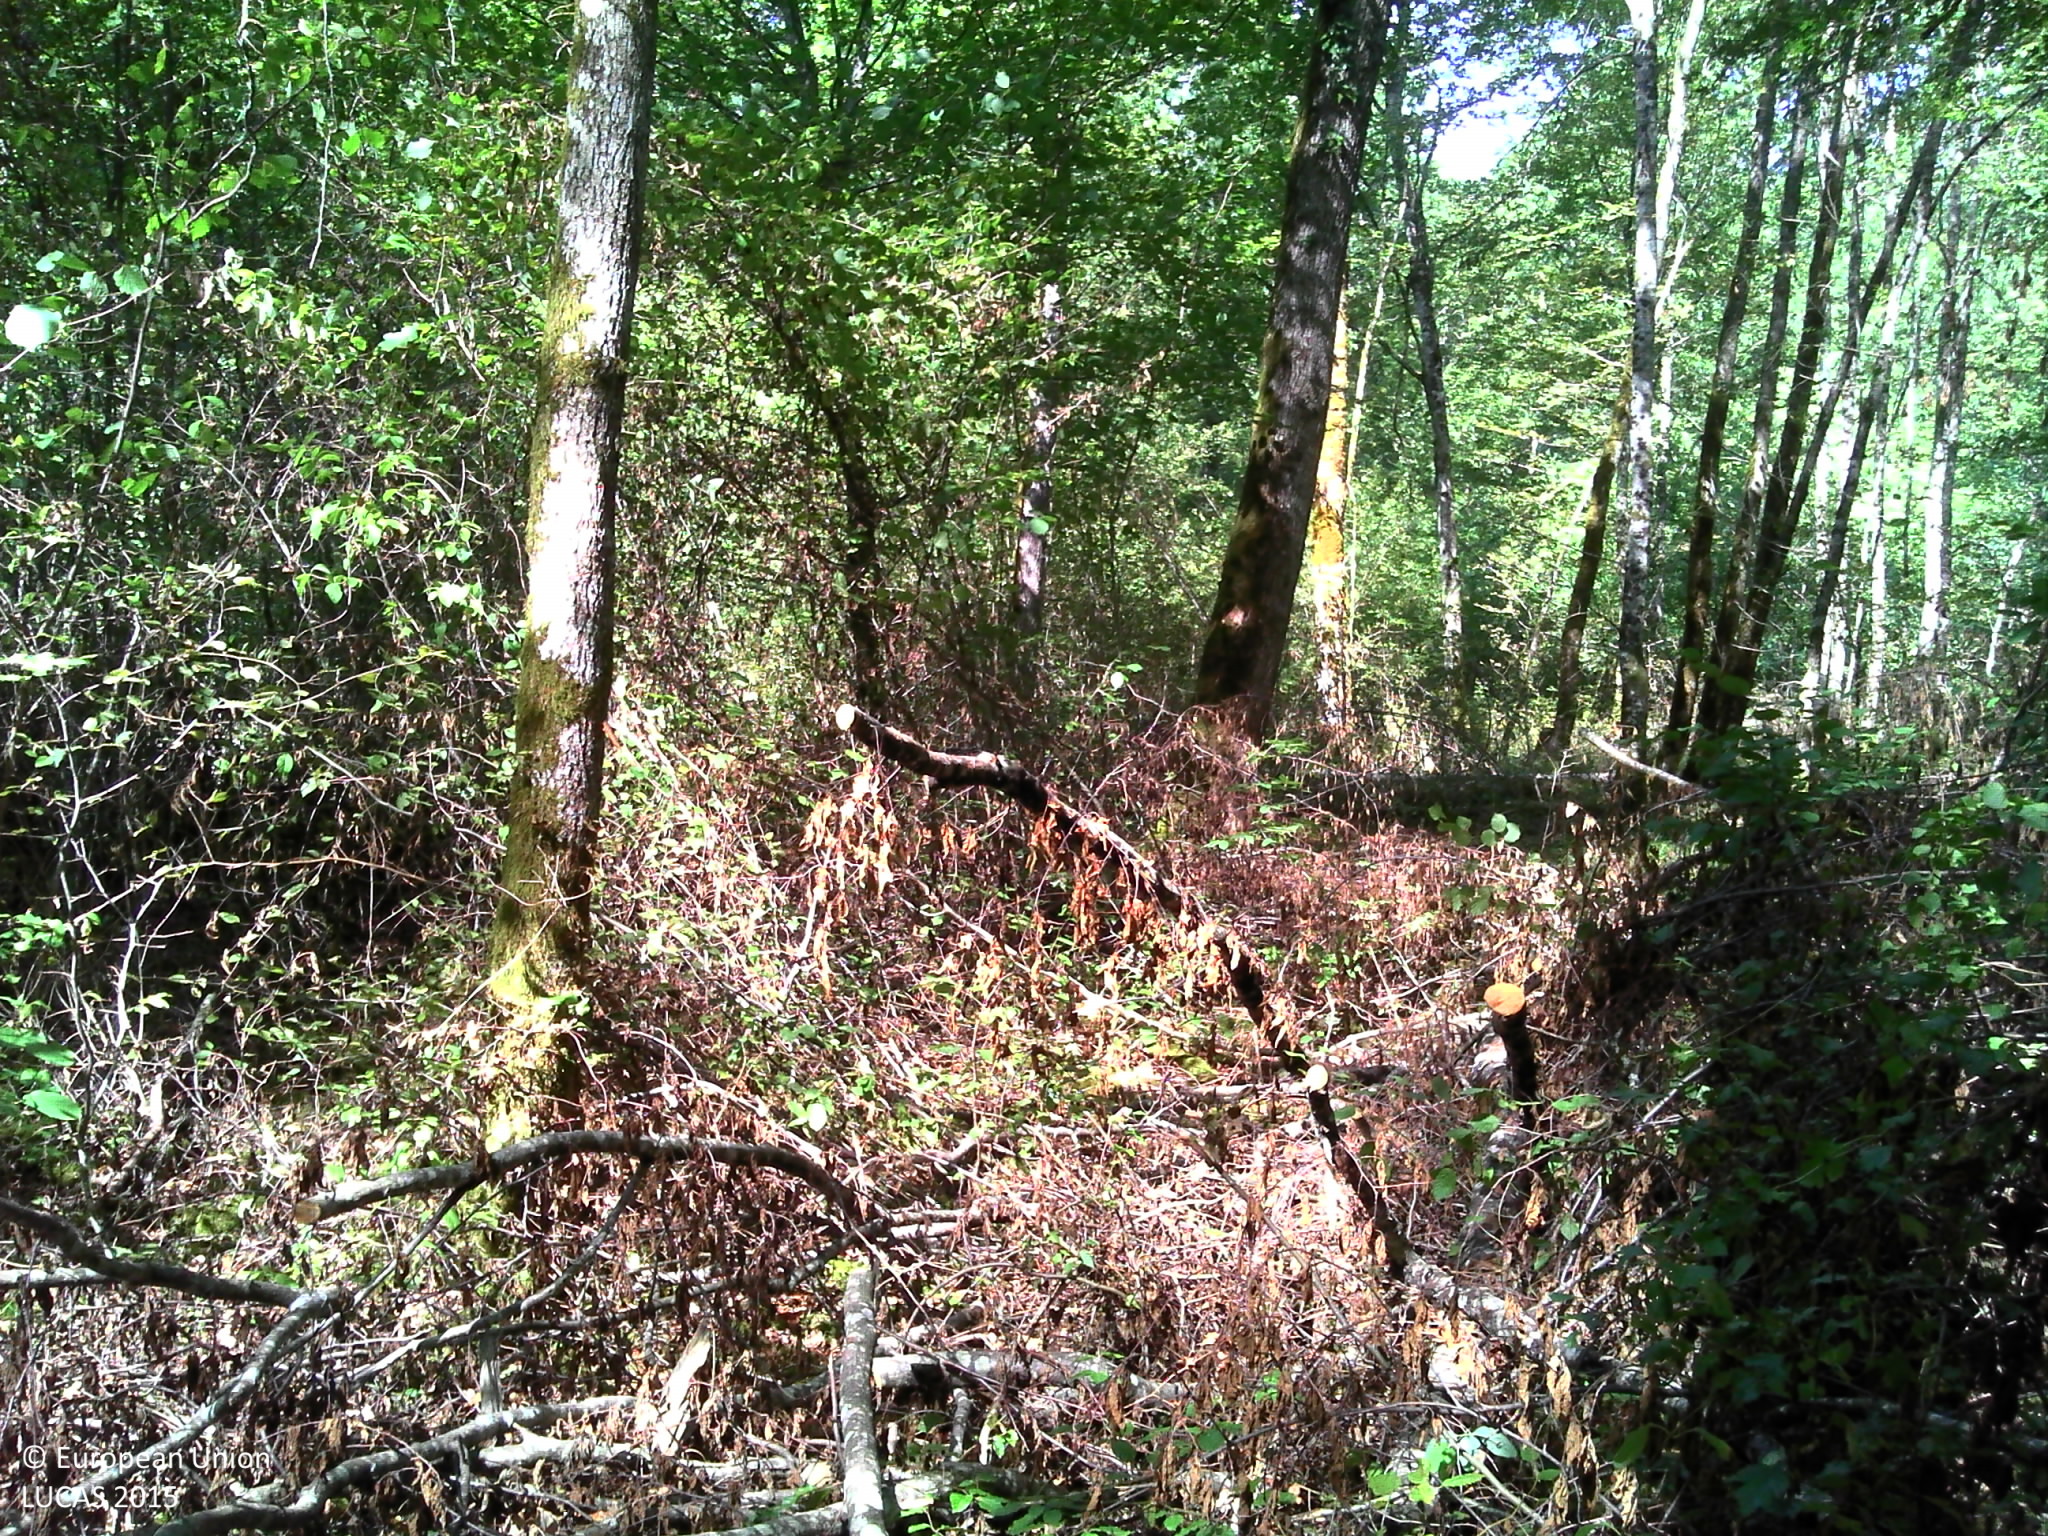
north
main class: Woodland
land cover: Broadleaved woodland
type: mesophytic deciduous forest
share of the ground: > 75 %
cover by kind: broadleaved forest trees 90 %, herbaceous plants 5 %, lichens and mosses 5 %
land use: Forestry
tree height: > 5 m
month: August
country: FR
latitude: 47.8228
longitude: 4.6426
